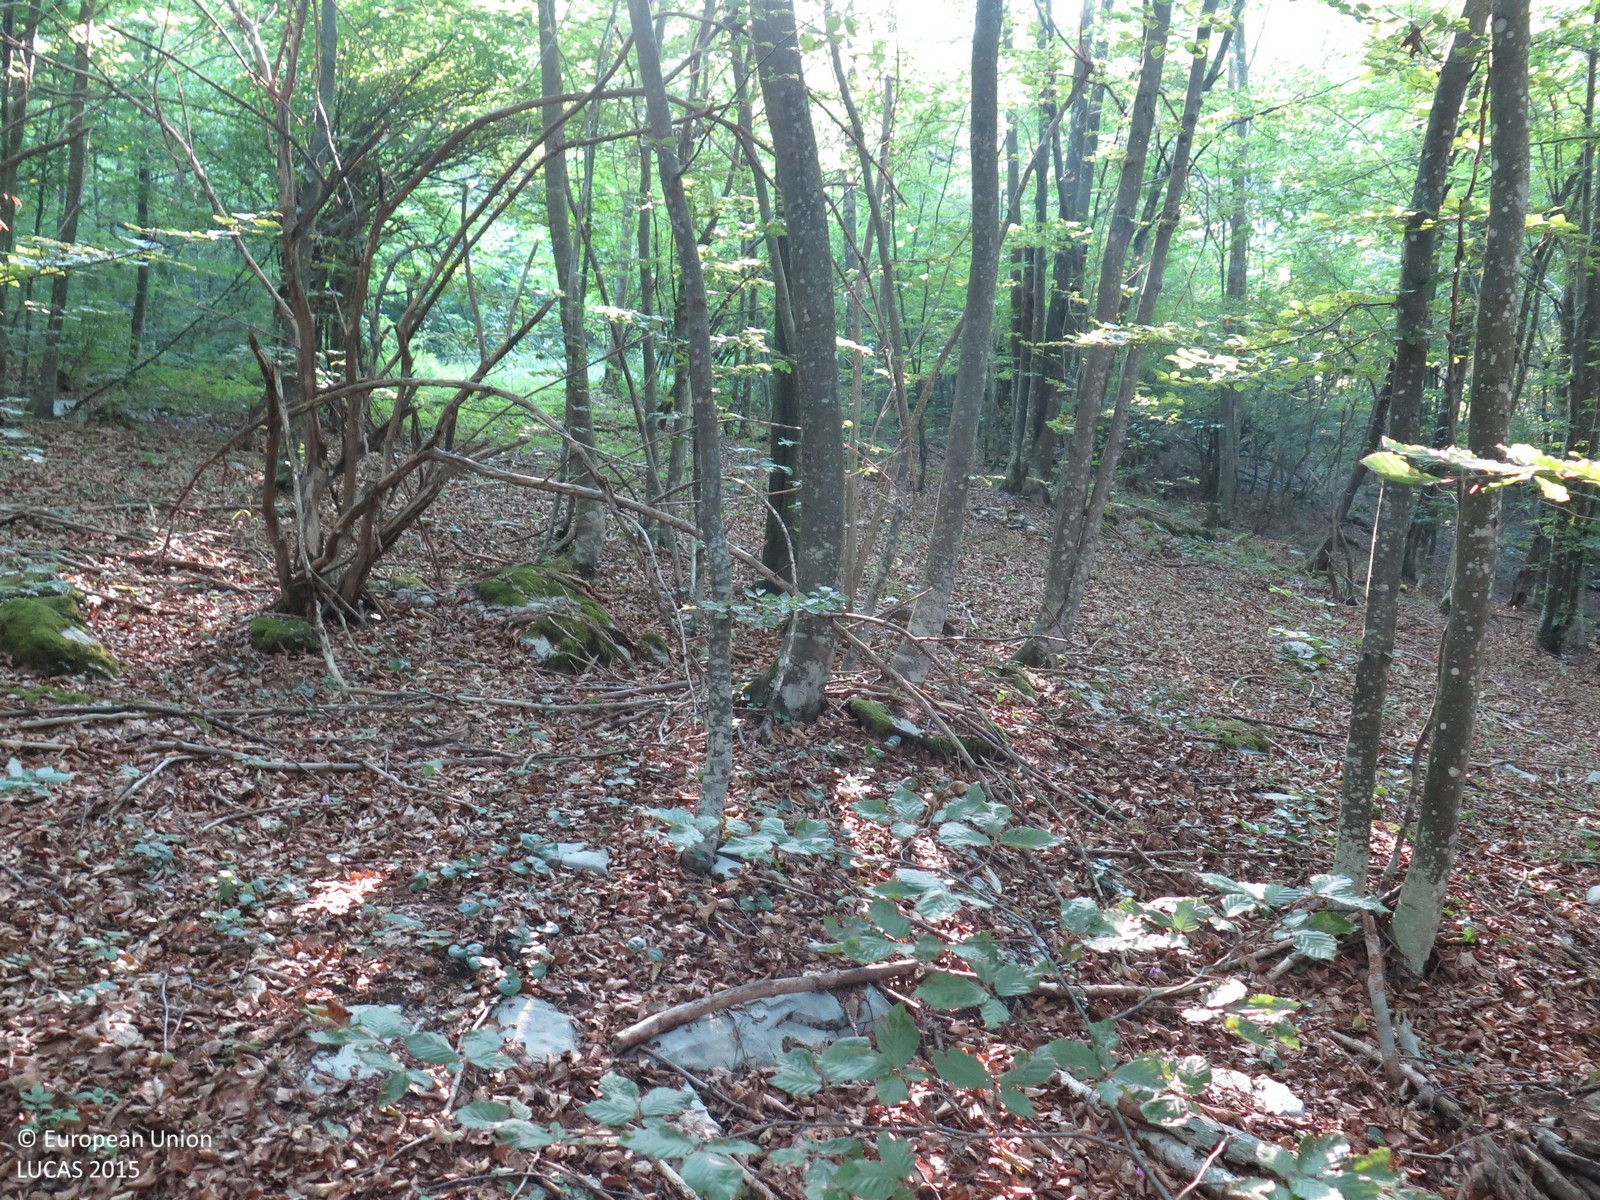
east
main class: Woodland
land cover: Broadleaved woodland
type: beech forest
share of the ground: > 75 %
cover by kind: broadleaved forest trees 95 %, lichens and mosses 5 %
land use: Forestry
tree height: > 5 m
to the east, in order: Broadleaved woodland; Tracks; Broadleaved woodland
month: August
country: HR
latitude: 45.4764
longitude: 14.9974
